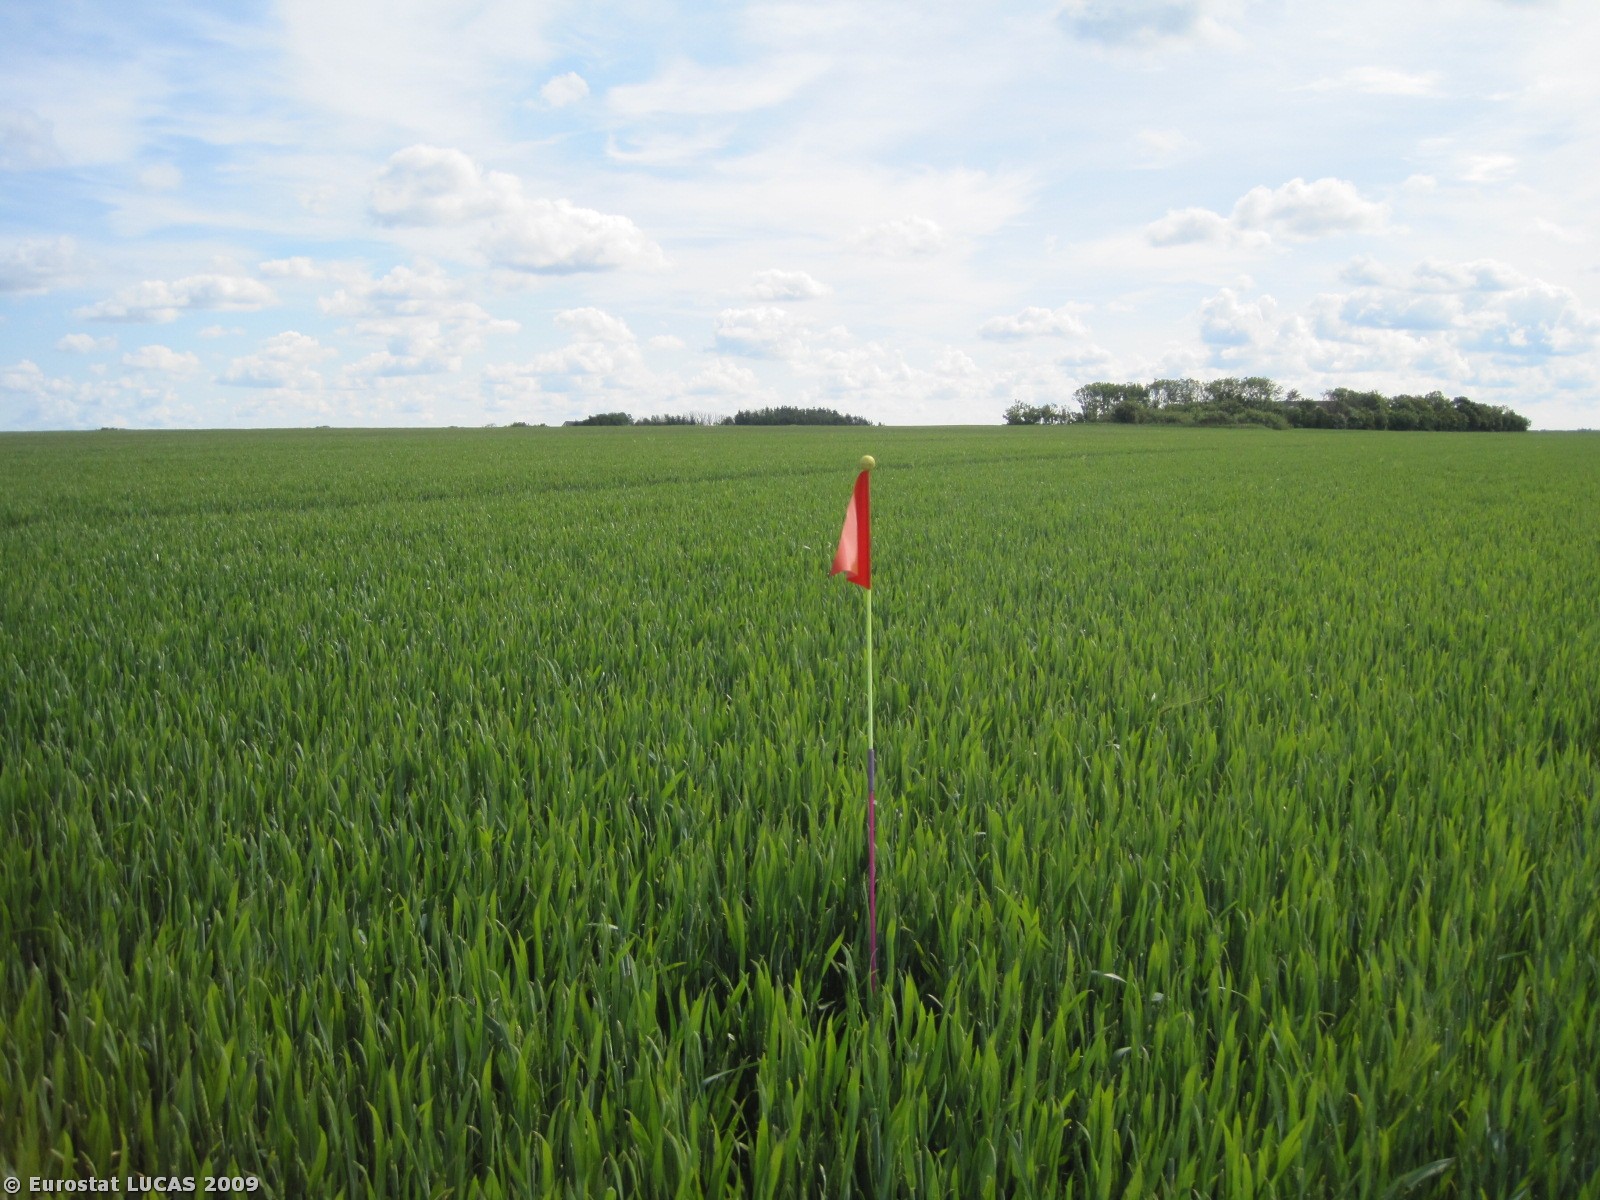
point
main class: Cropland
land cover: Common wheat
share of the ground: > 75 %
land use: Agriculture (excluding fallow land and kitchen gardens)
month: June
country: DK
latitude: 57.4101
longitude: 9.8504
